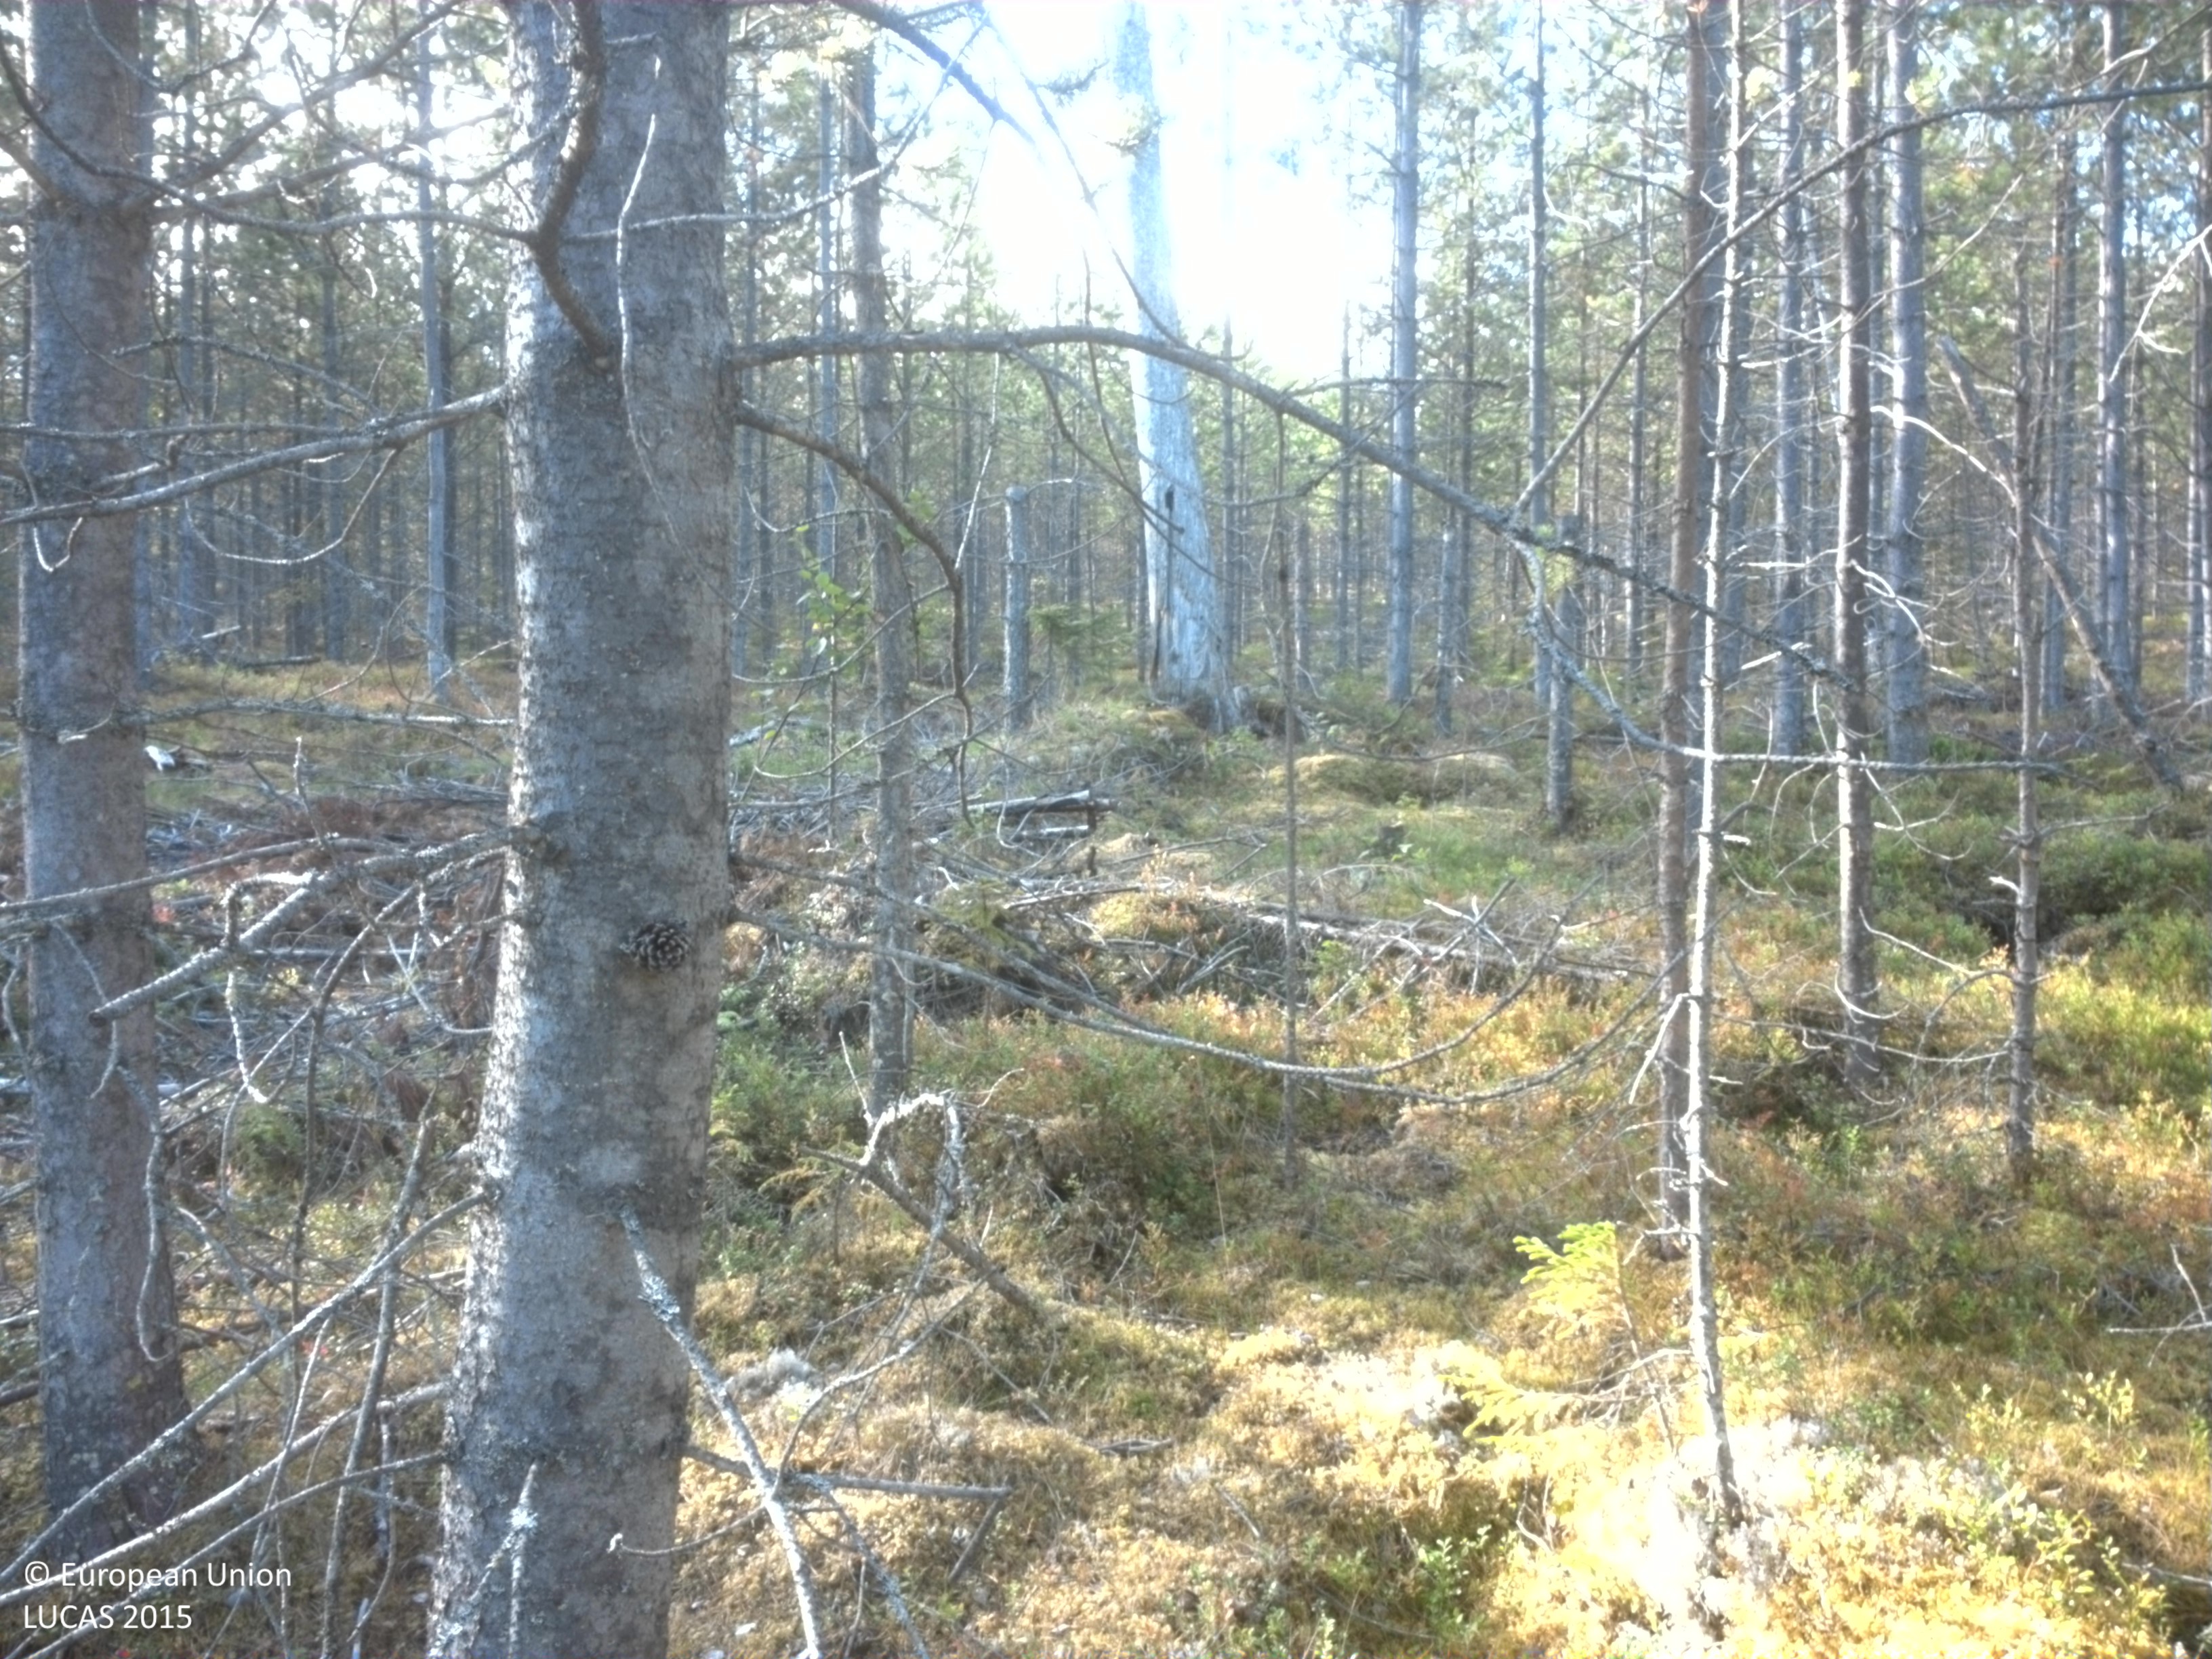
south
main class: Woodland
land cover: Pine dominated coniferous woodland
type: exotic forest
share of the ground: 50 - 75 %
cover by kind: coniferous forest trees 70 %, shrubs 20 %, lichens and mosses 10 %
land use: Forestry
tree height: > 5 m
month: September
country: SE
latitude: 64.5560
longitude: 19.0858
